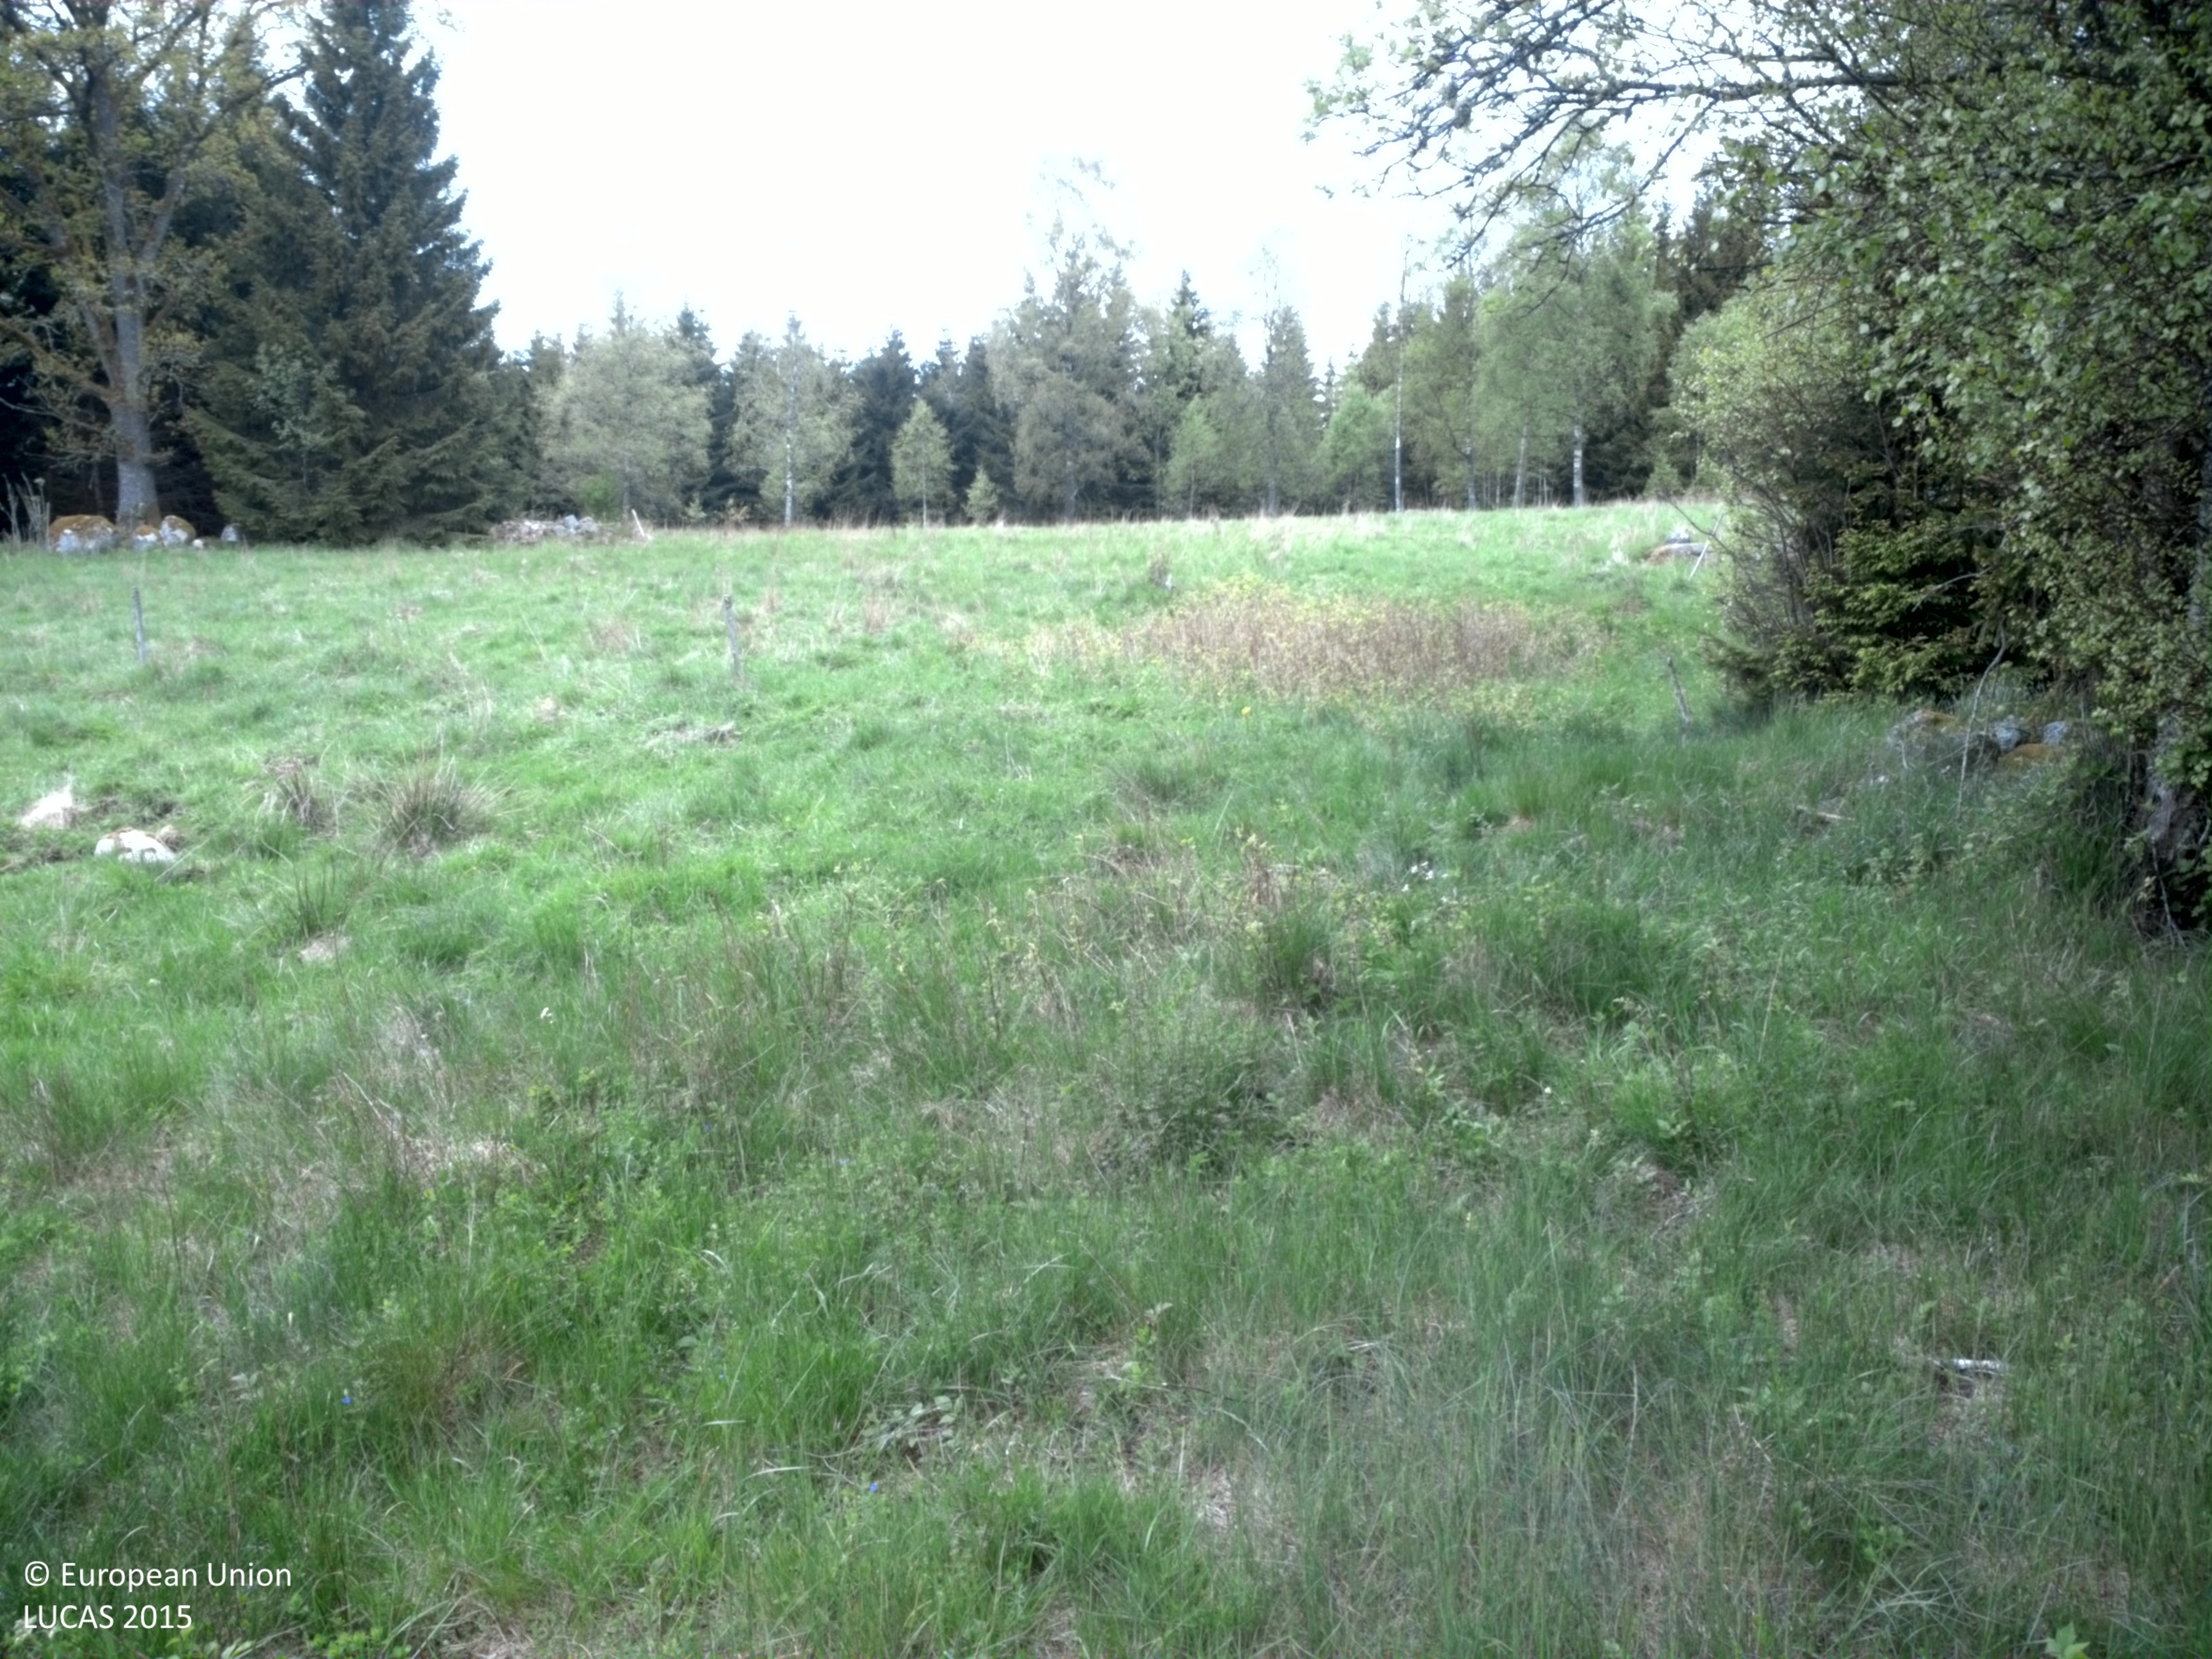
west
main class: Woodland
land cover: Broadleaved woodland
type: hemiboreal forest and nemoral coniferous forest and mixed broadleaved-coniferous forest
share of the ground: 10 - 25 %
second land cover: Grassland without tree/shrub cover
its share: 50 - 75 %
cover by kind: herbaceous plants 75 %, broadleaved forest trees 15 %, shrubs 10 %
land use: Forestry
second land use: Agriculture (excluding fallow land and kitchen gardens)
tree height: < 5 m
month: May
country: SE
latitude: 56.6371
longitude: 15.2972
